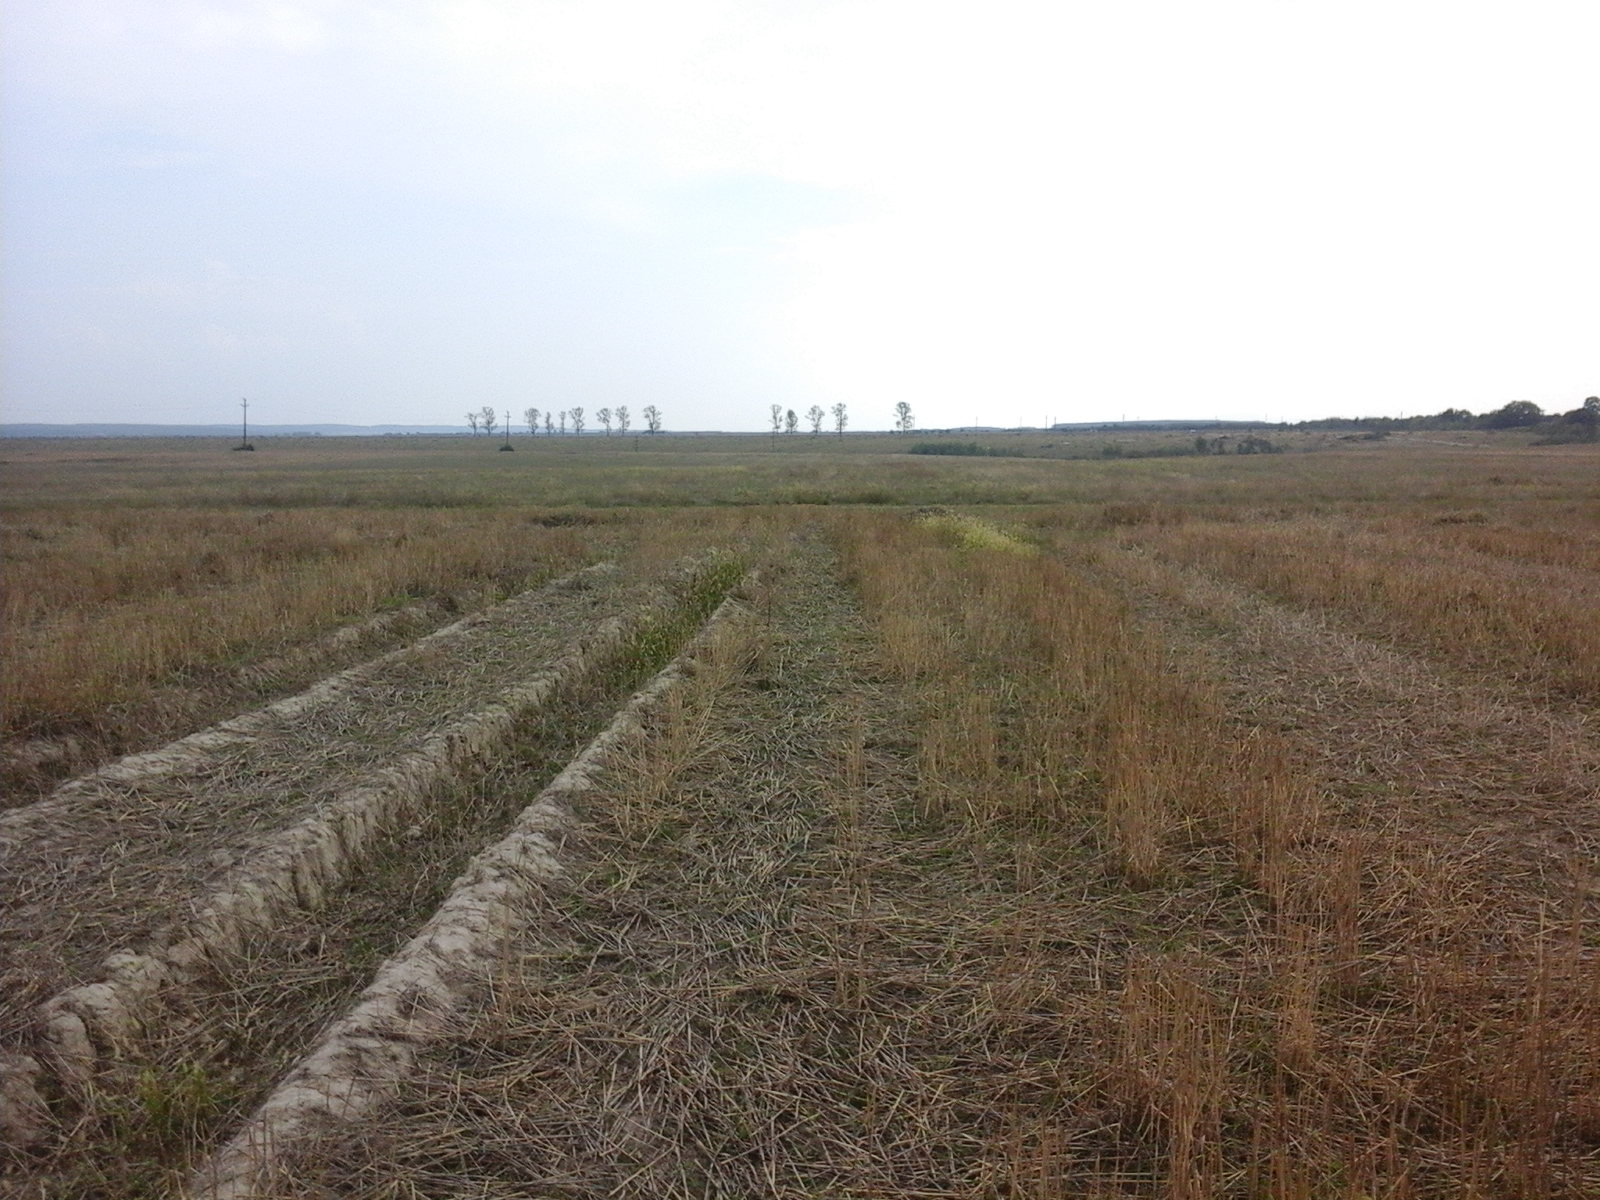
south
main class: Cropland
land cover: Common wheat
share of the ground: 25 - 50 %
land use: Agriculture (excluding fallow land and kitchen gardens)
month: August
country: RO
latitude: 46.6257
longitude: 21.9422
